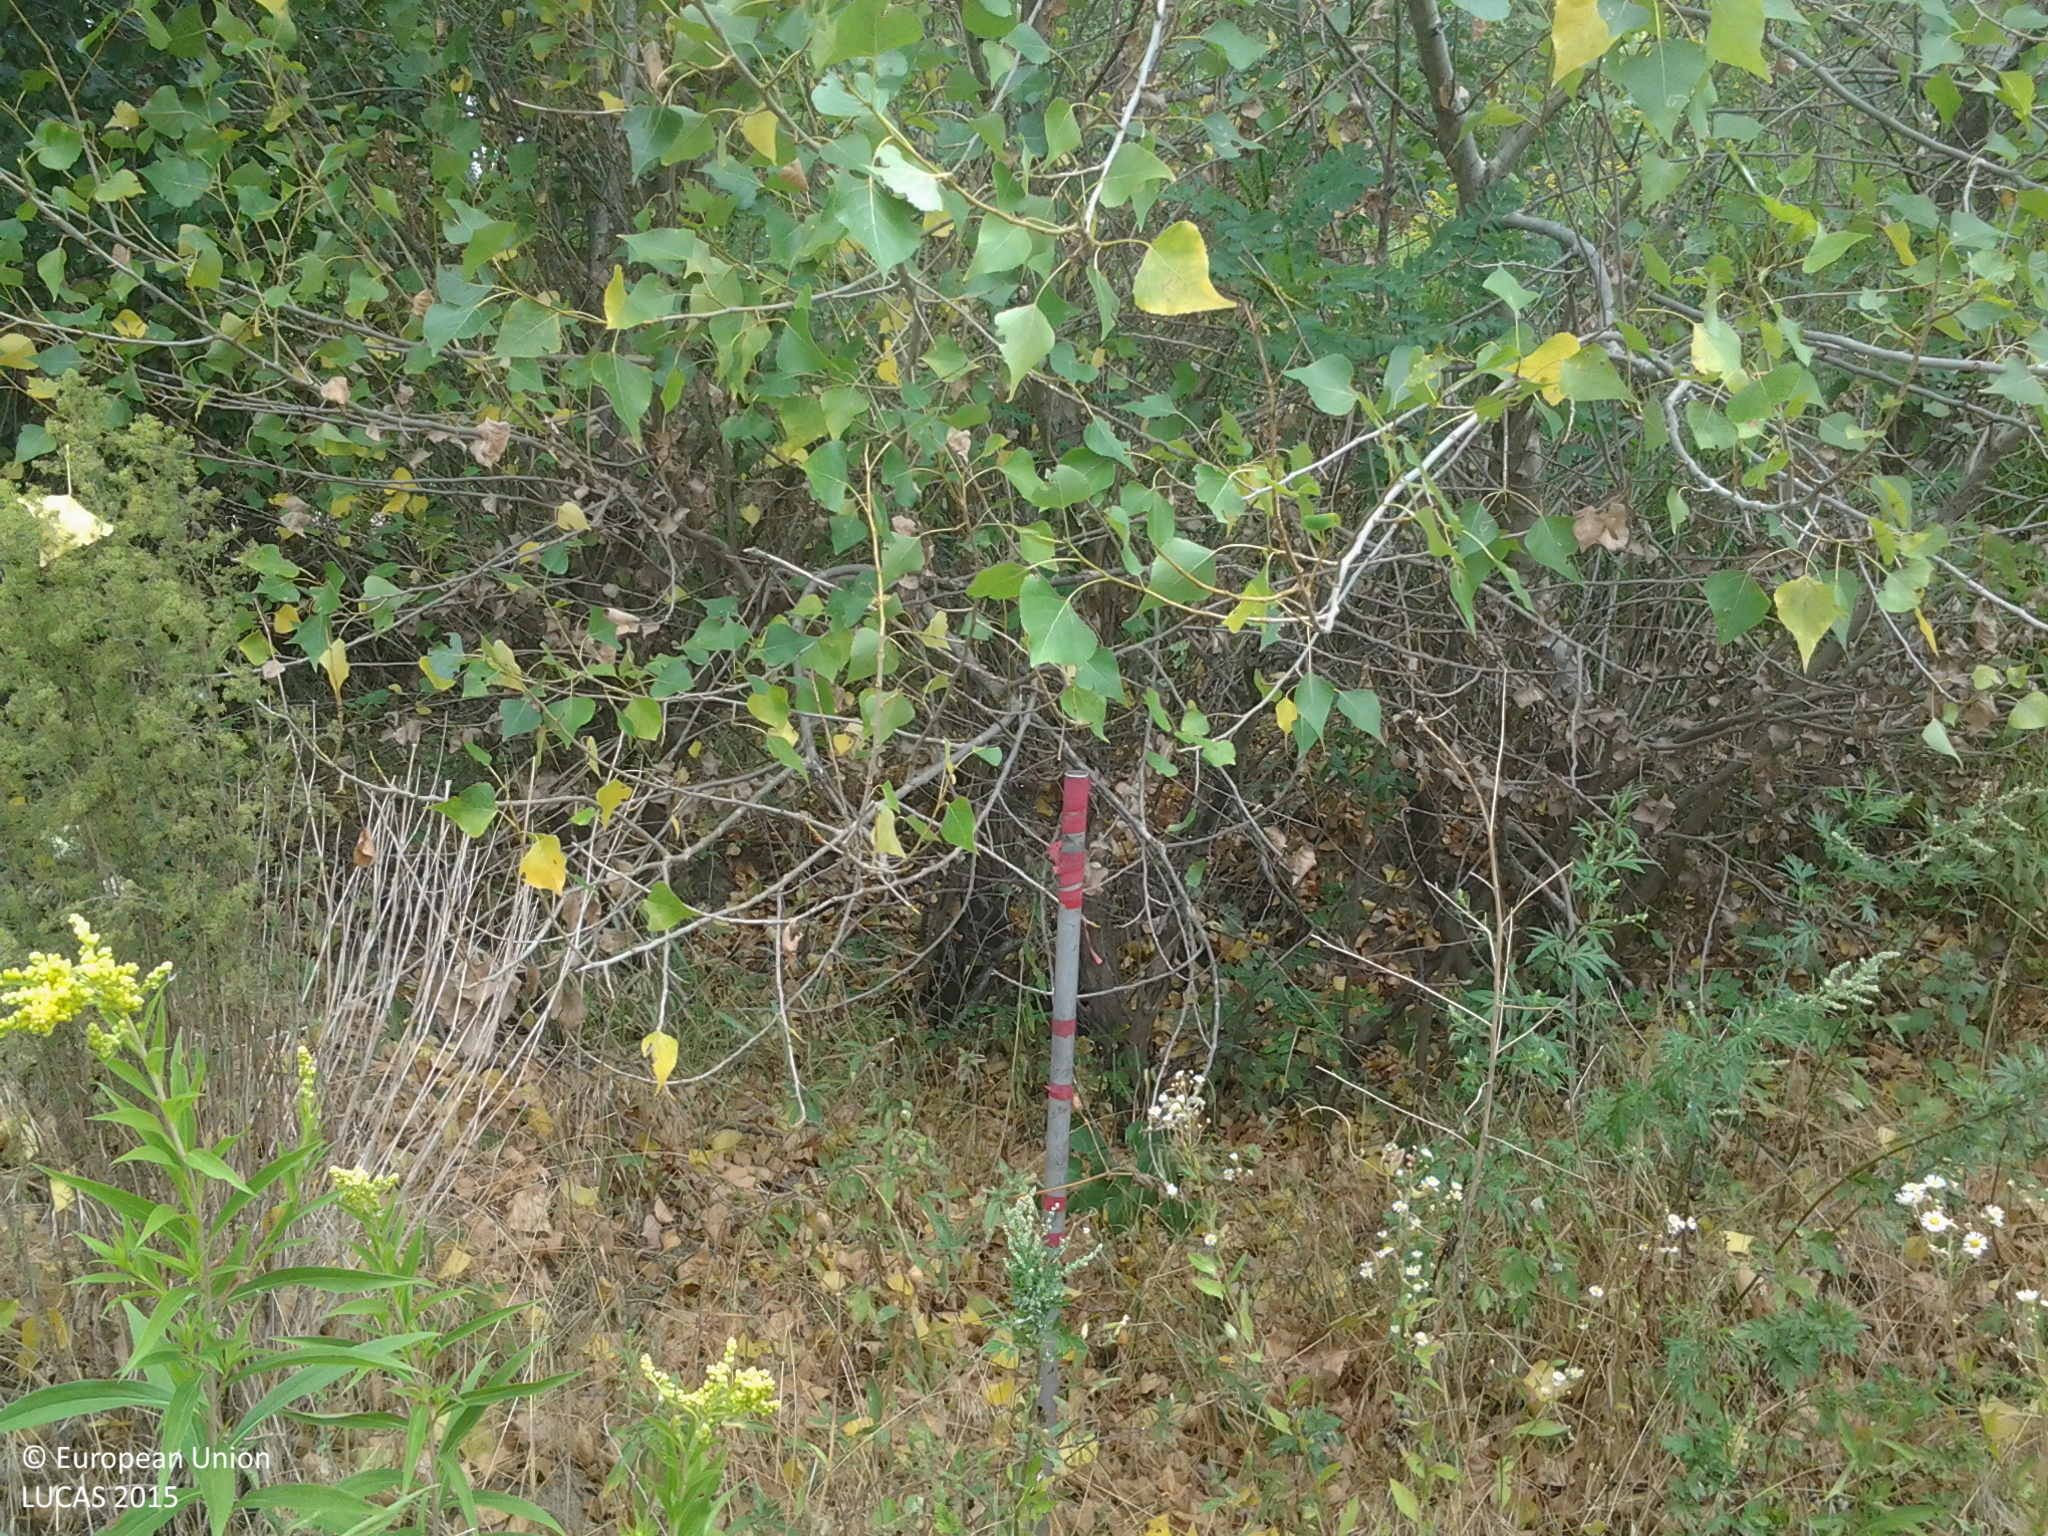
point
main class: Woodland
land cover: Broadleaved woodland
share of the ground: 50 - 75 %
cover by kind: broadleaved forest trees 70 %, herbaceous plants 20 %, shrubs 10 %
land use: Forestry
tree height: > 5 m
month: July
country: HU
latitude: 46.9882
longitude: 18.9693
